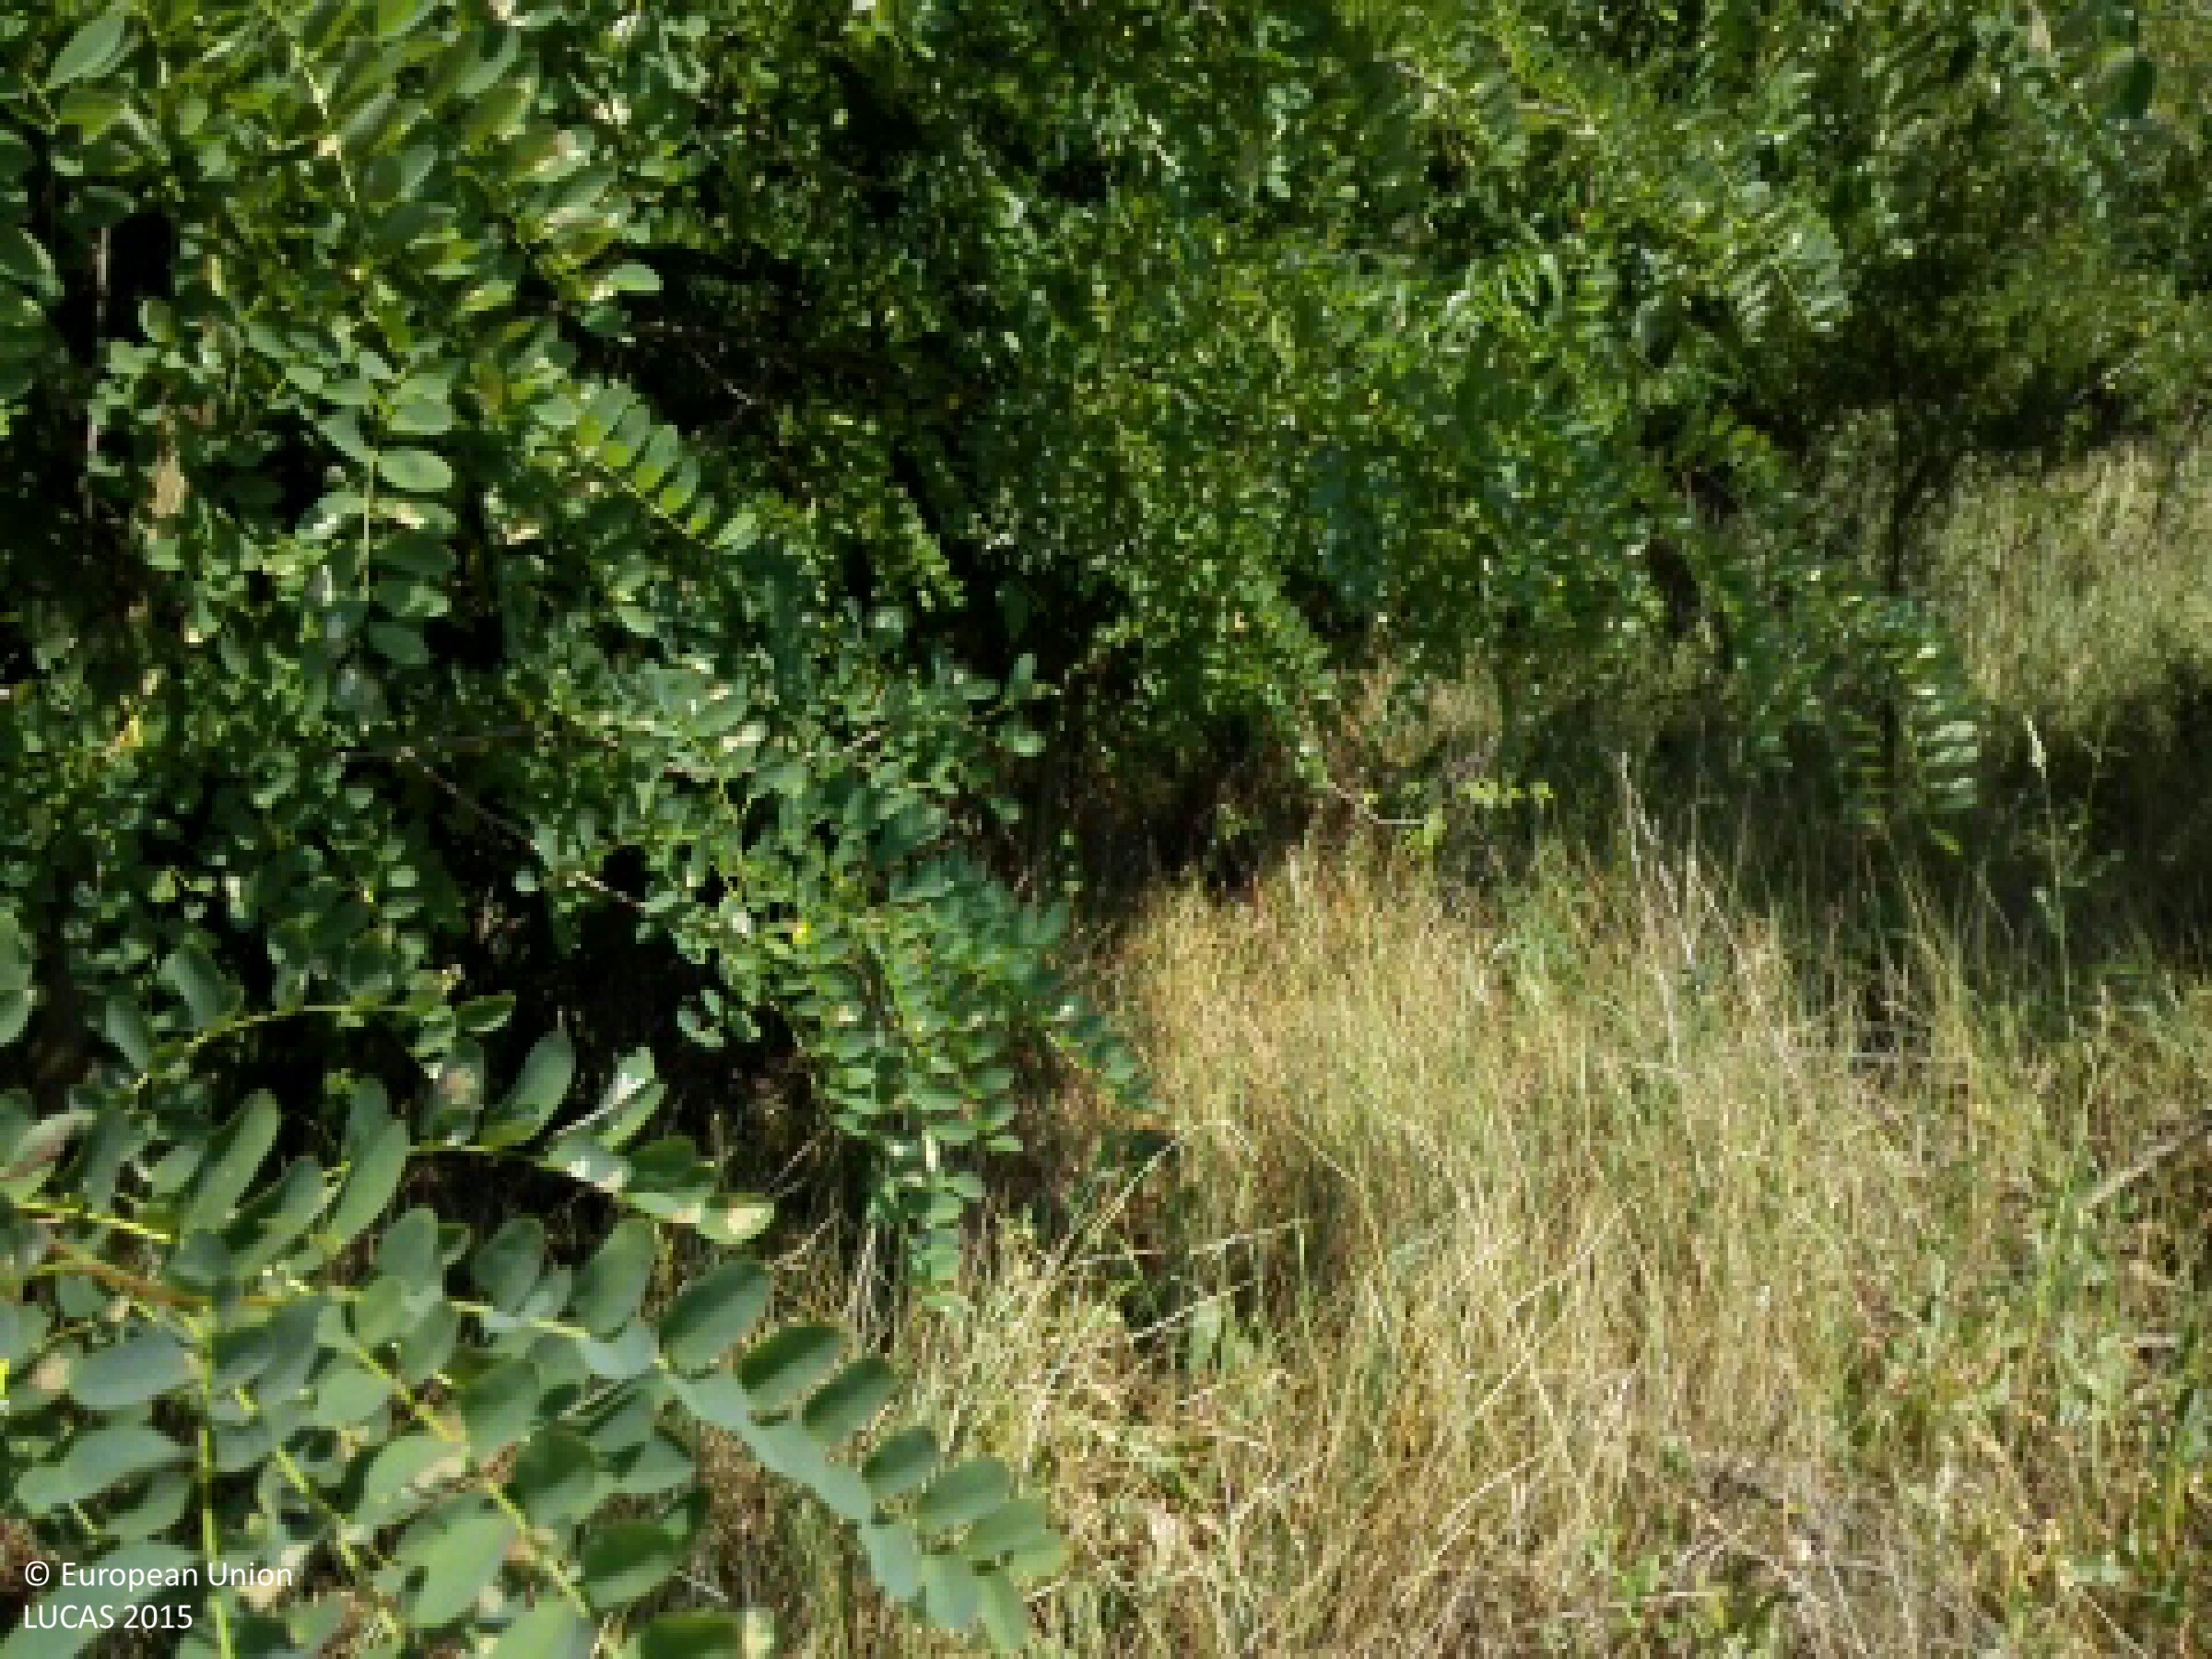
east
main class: Woodland
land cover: Broadleaved woodland
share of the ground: > 75 %
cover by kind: broadleaved forest trees 40 %, shrubs 30 %, herbaceous plants 30 %
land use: Semi-natural and natural areas not in use
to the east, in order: Broadleaved woodland; Tracks; Broadleaved woodland; Grass margins; Tracks; Grass margins; Maize; Grassland without tree/shrub cover; Tracks; Grassland without tree/shrub cover; Tracks; Grassland without tree/shrub cover; Lines of trees; Maize
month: July
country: HU
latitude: 47.6943
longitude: 21.6512
